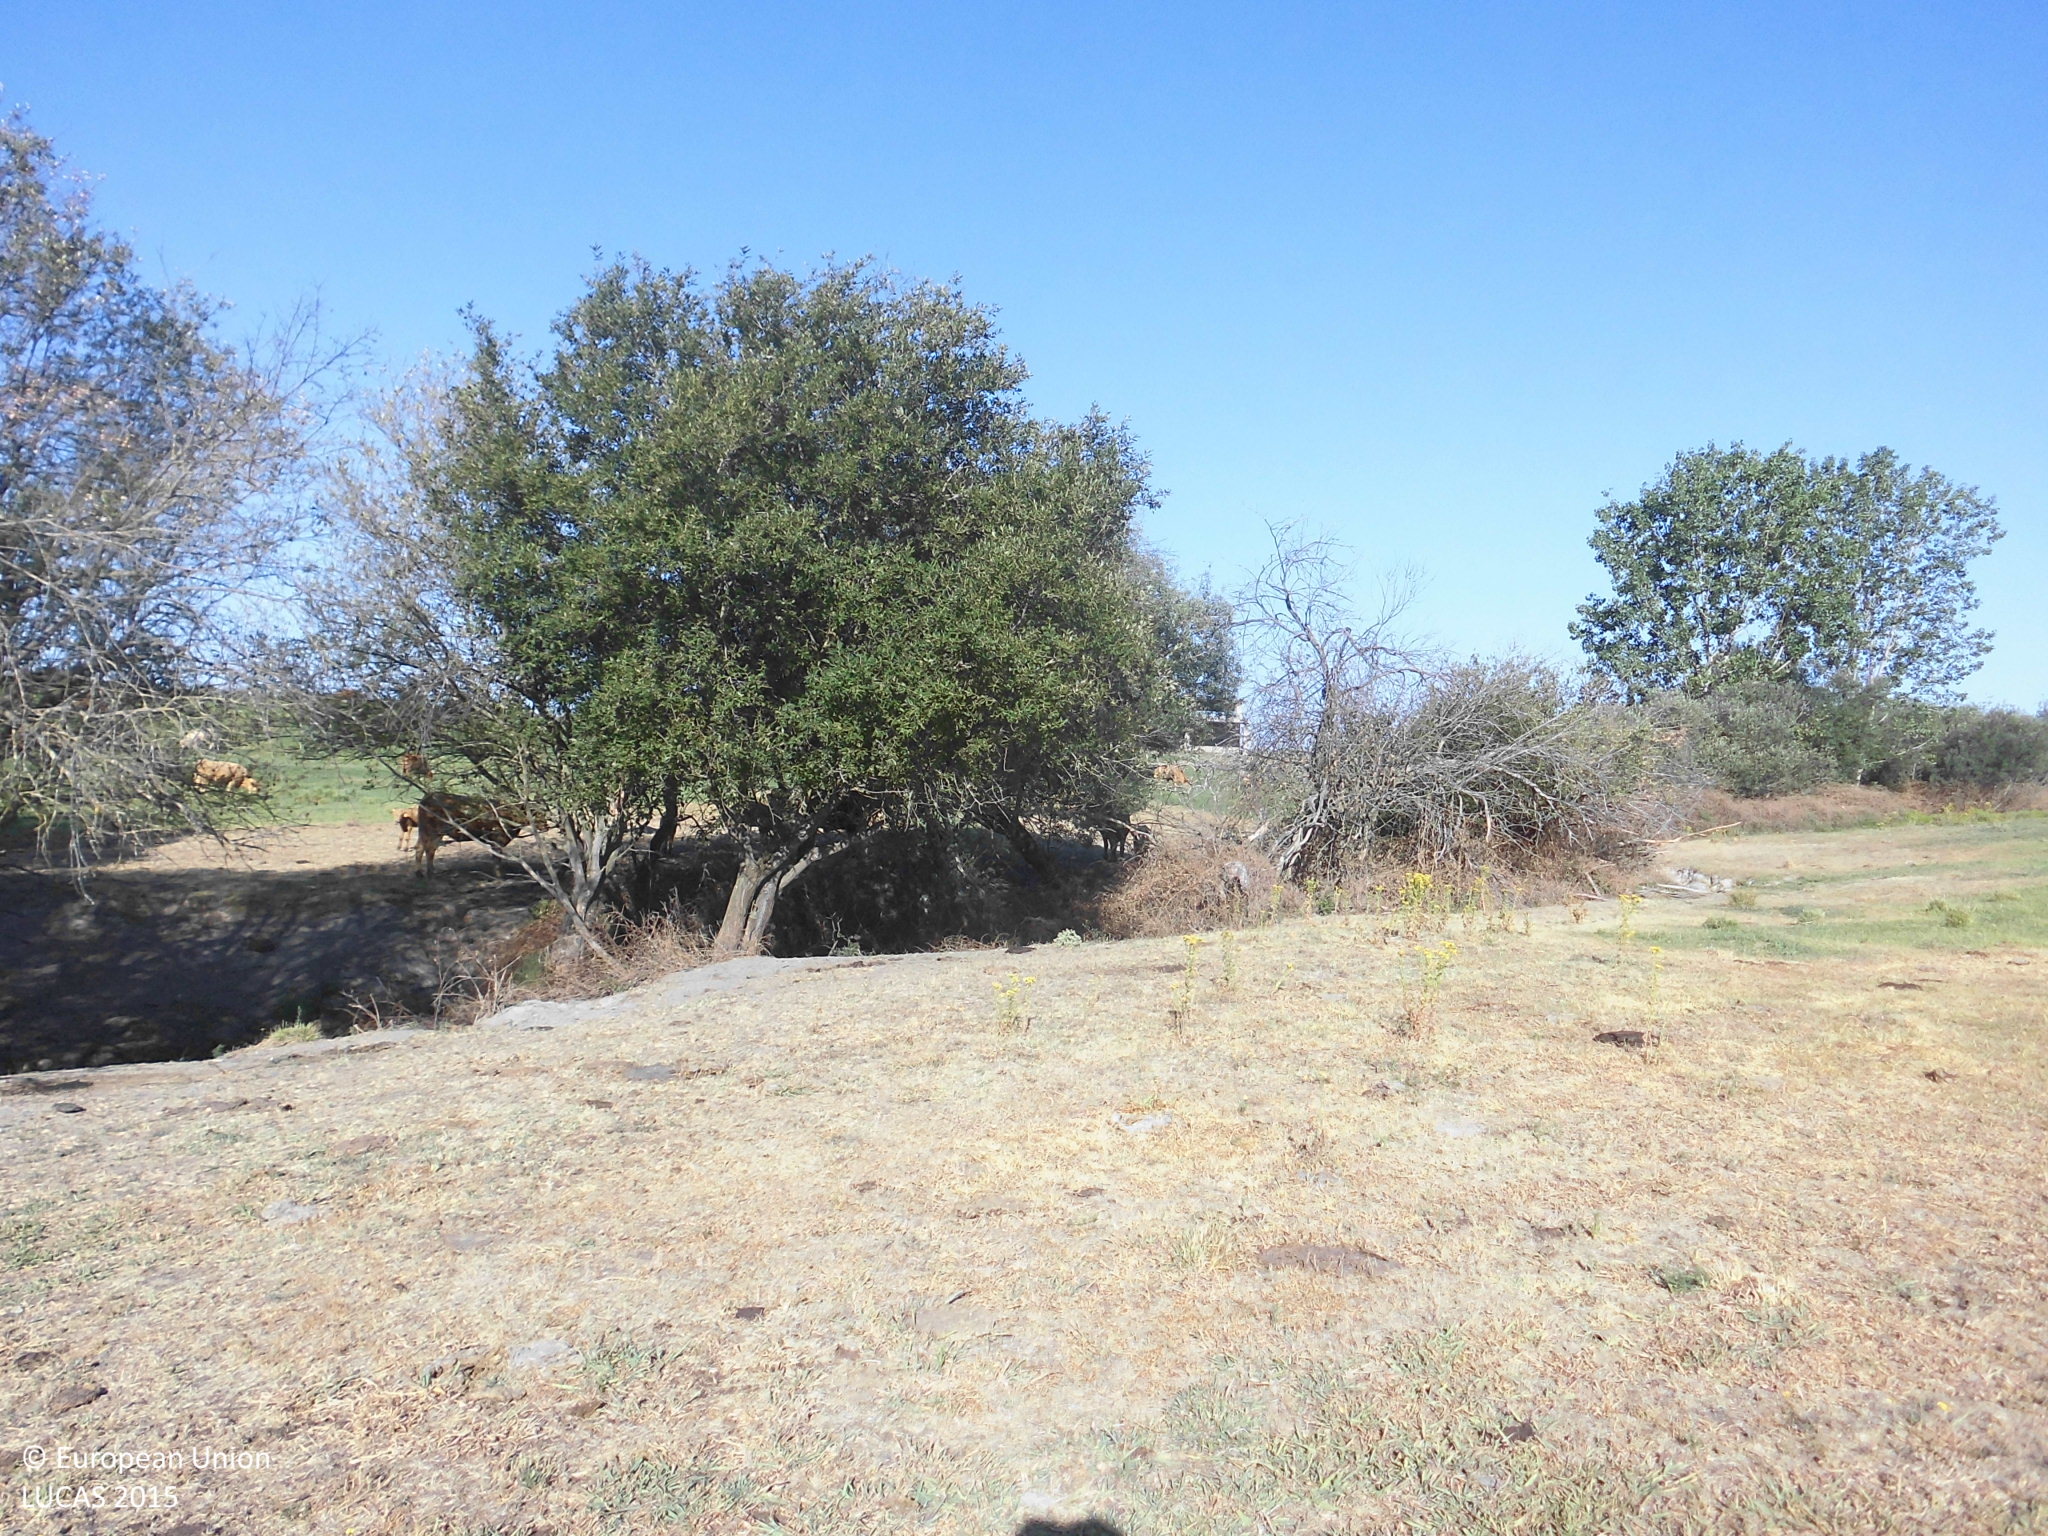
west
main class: Cropland
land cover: Temporary grasslands
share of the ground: > 75 %
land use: Agriculture (excluding fallow land and kitchen gardens)
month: July
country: ES
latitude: 40.0673
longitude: -6.2197
